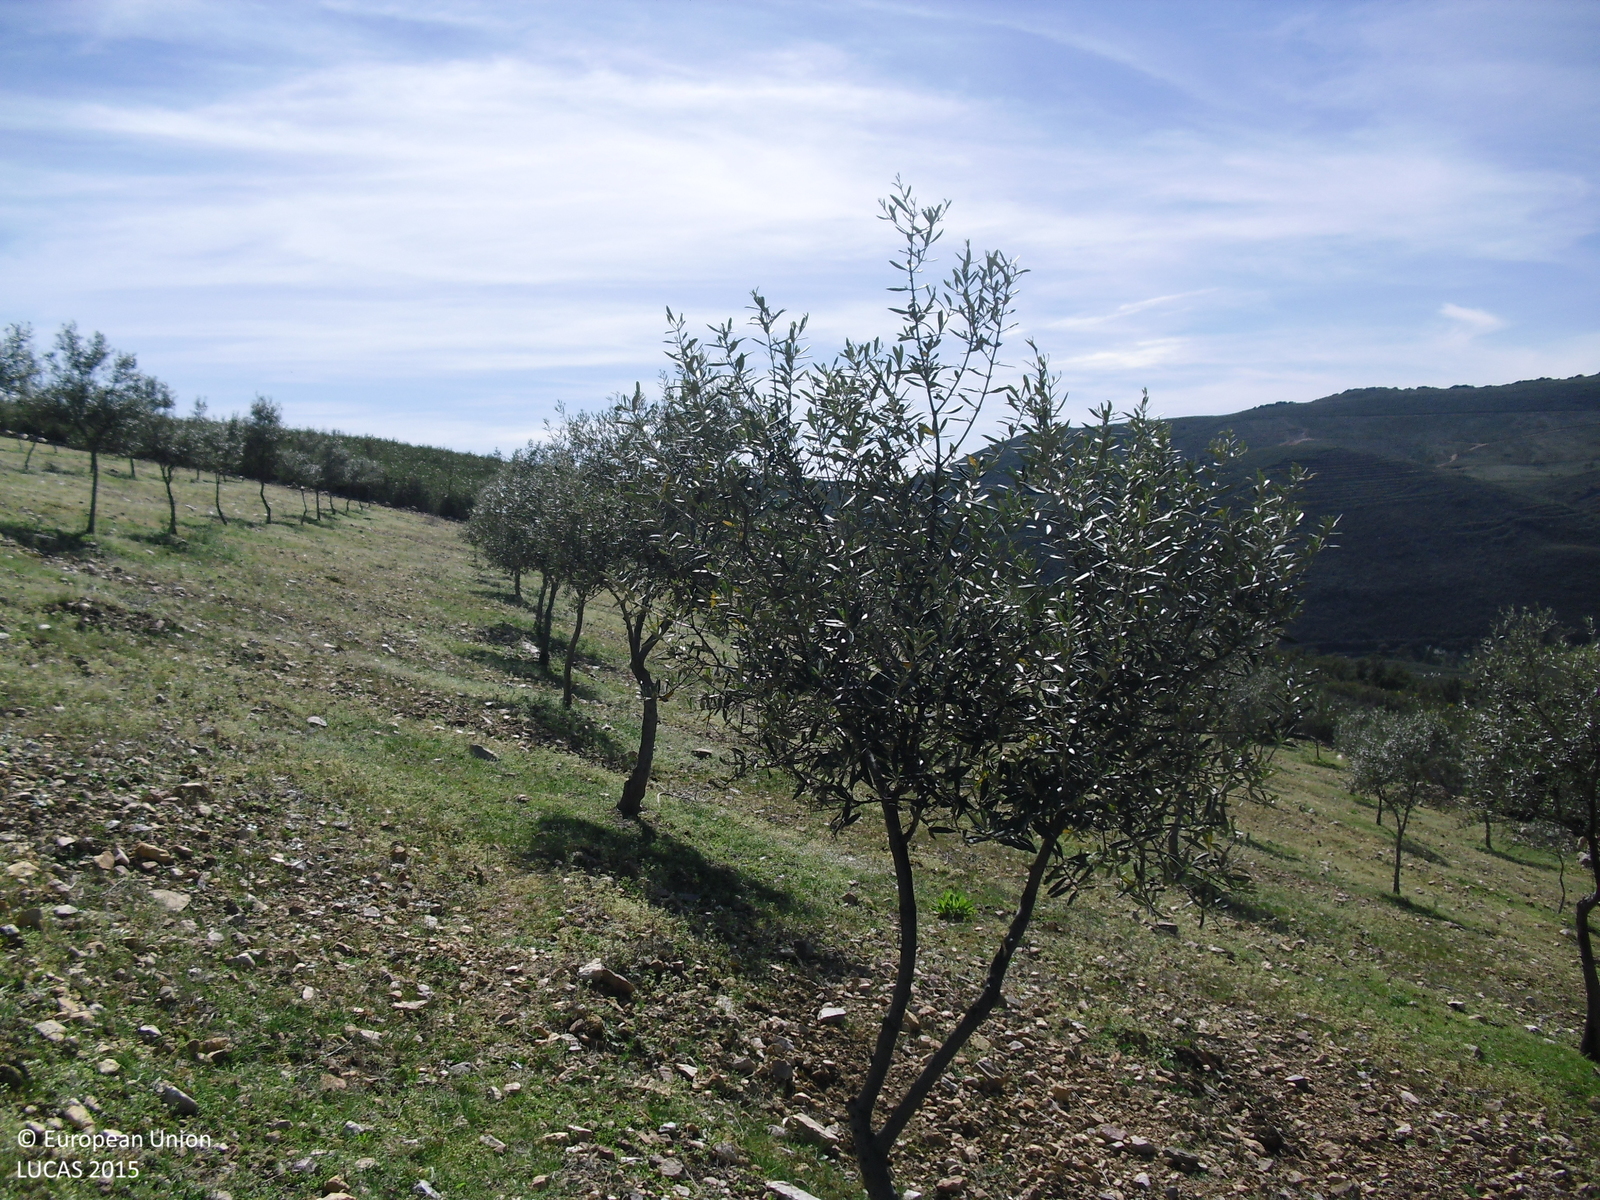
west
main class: Cropland
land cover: Olive groves
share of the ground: 10 - 25 %
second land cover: Spontaneously vegetated surfaces
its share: > 75 %
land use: Agriculture (excluding fallow land and kitchen gardens)
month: April
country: ES
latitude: 39.3665
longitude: -5.3330
